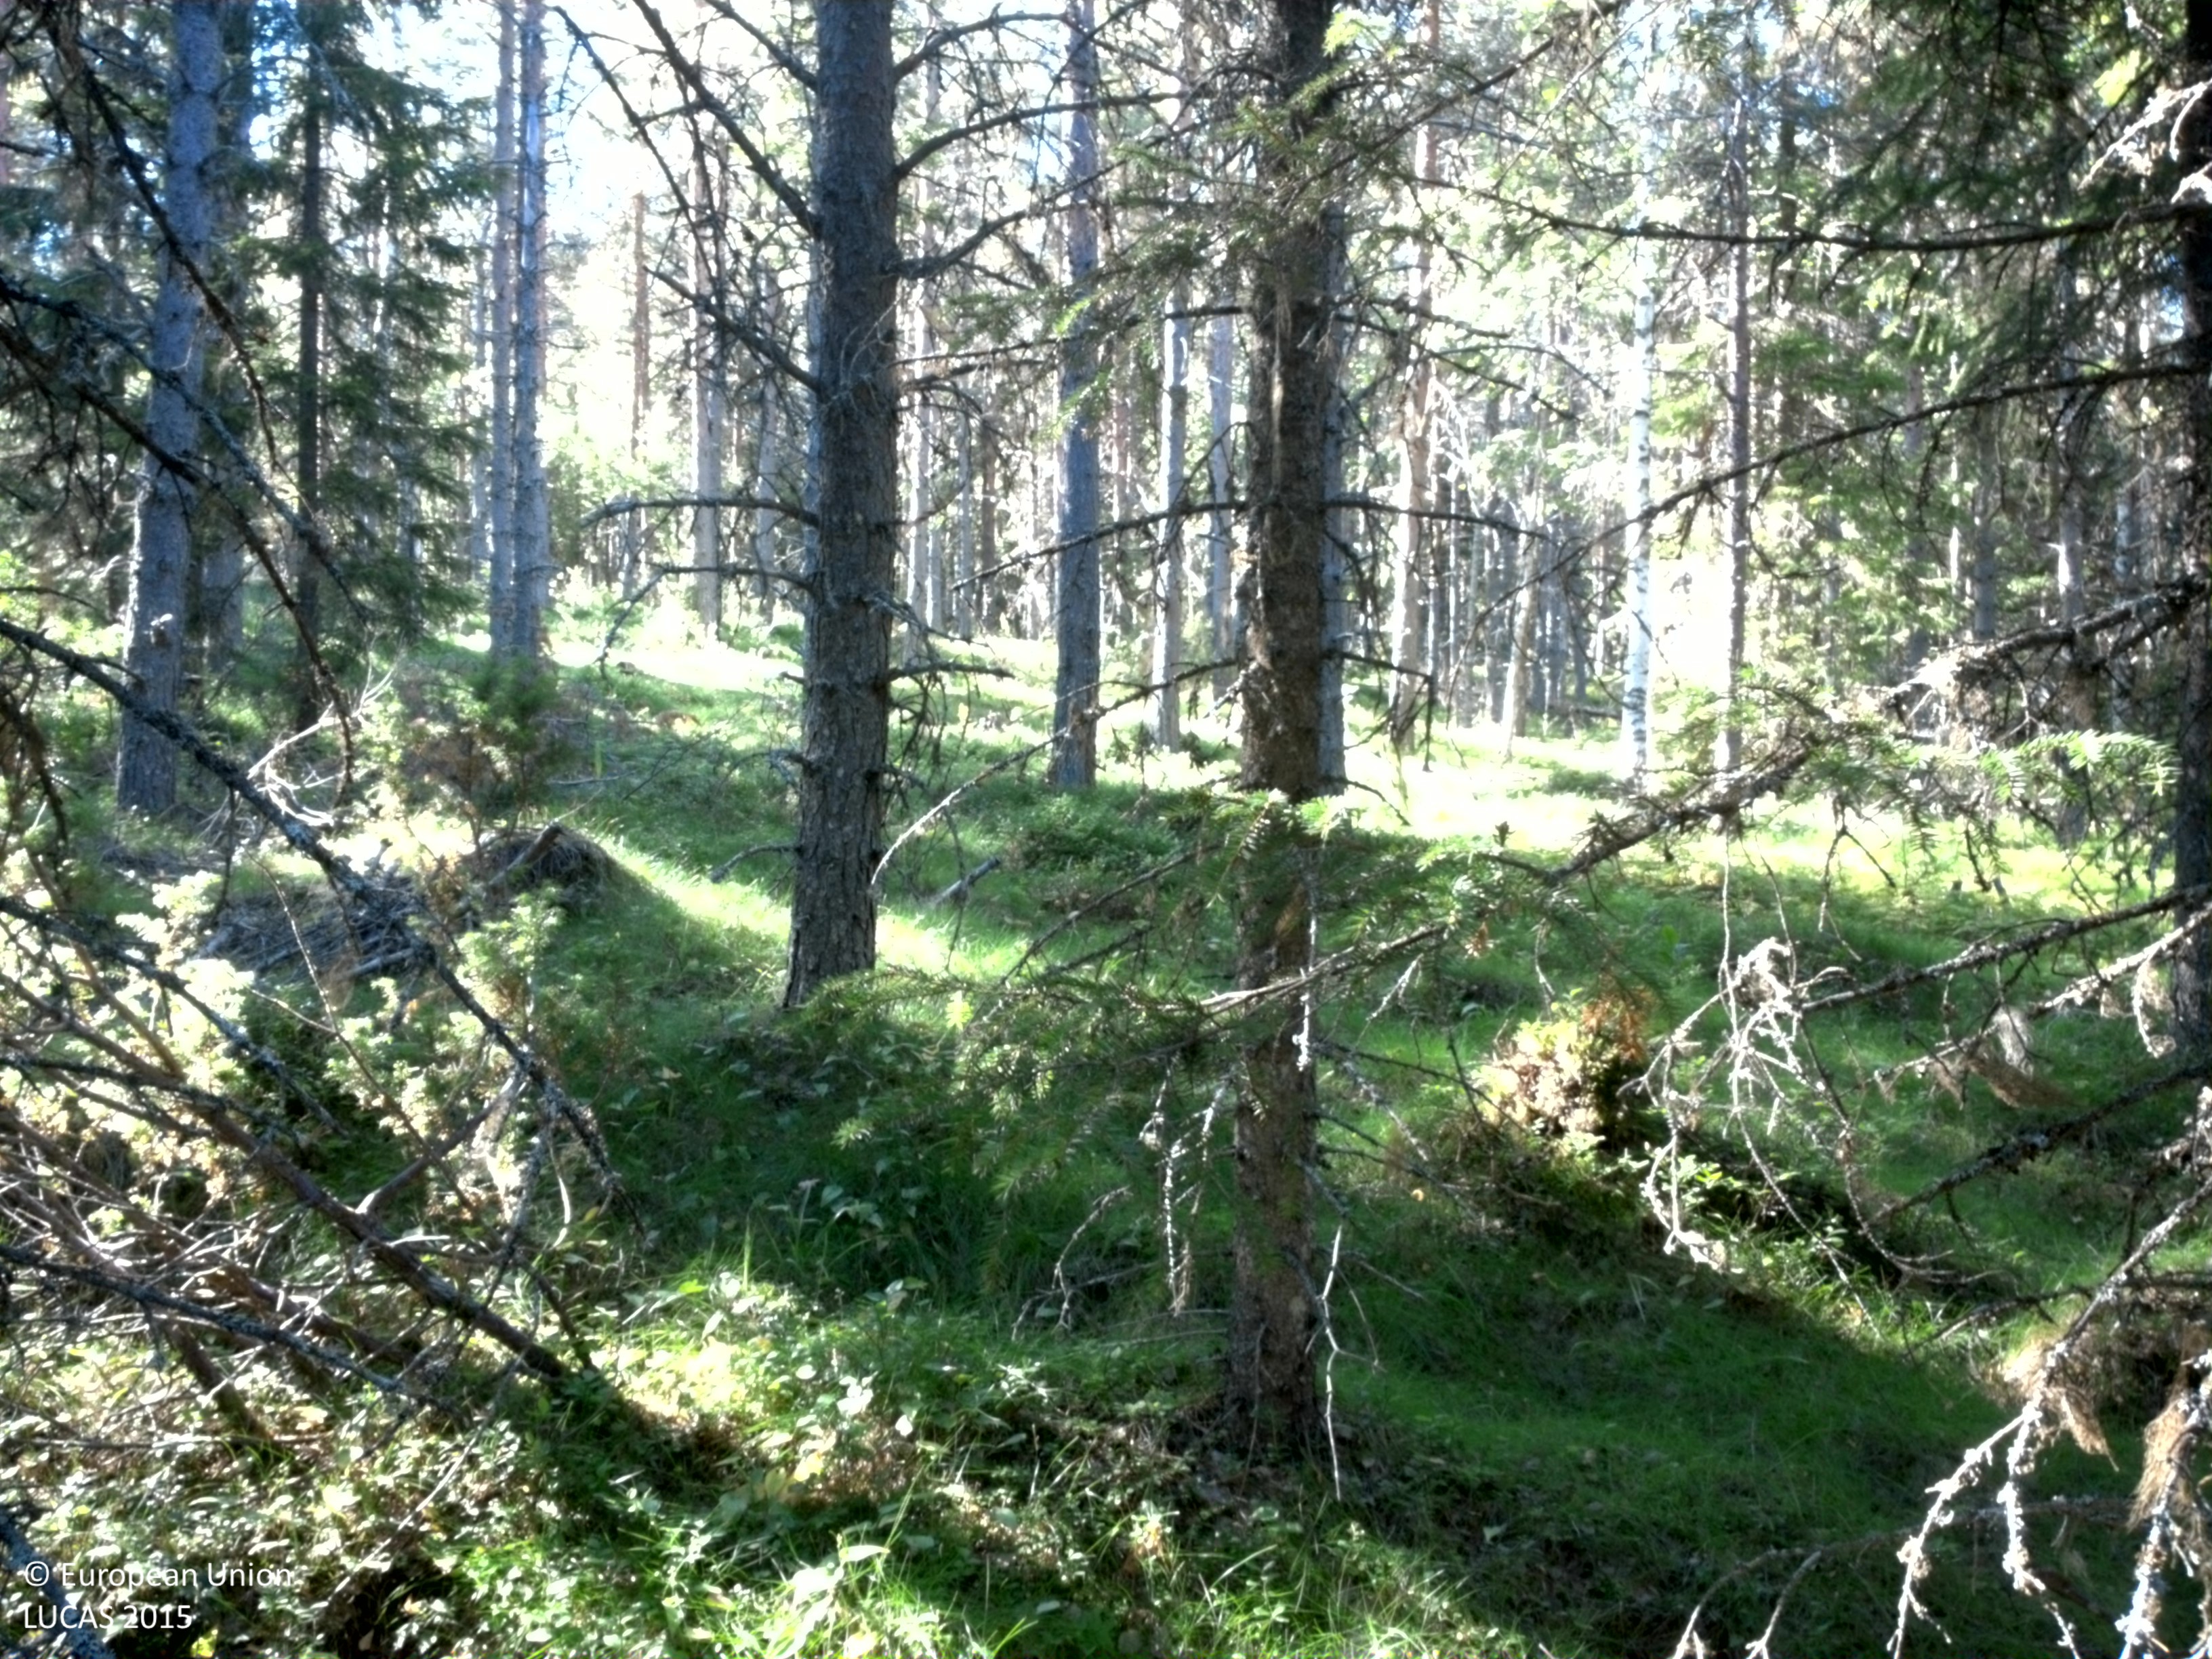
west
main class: Woodland
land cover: Spruce dominated coniferous woodland
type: boreal forest
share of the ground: 50 - 75 %
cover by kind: coniferous forest trees 60 %, herbaceous plants 20 %, shrubs 15 %, broadleaved forest trees 5 %
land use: Forestry
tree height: > 5 m
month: August
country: SE
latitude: 64.4872
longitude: 18.6878
